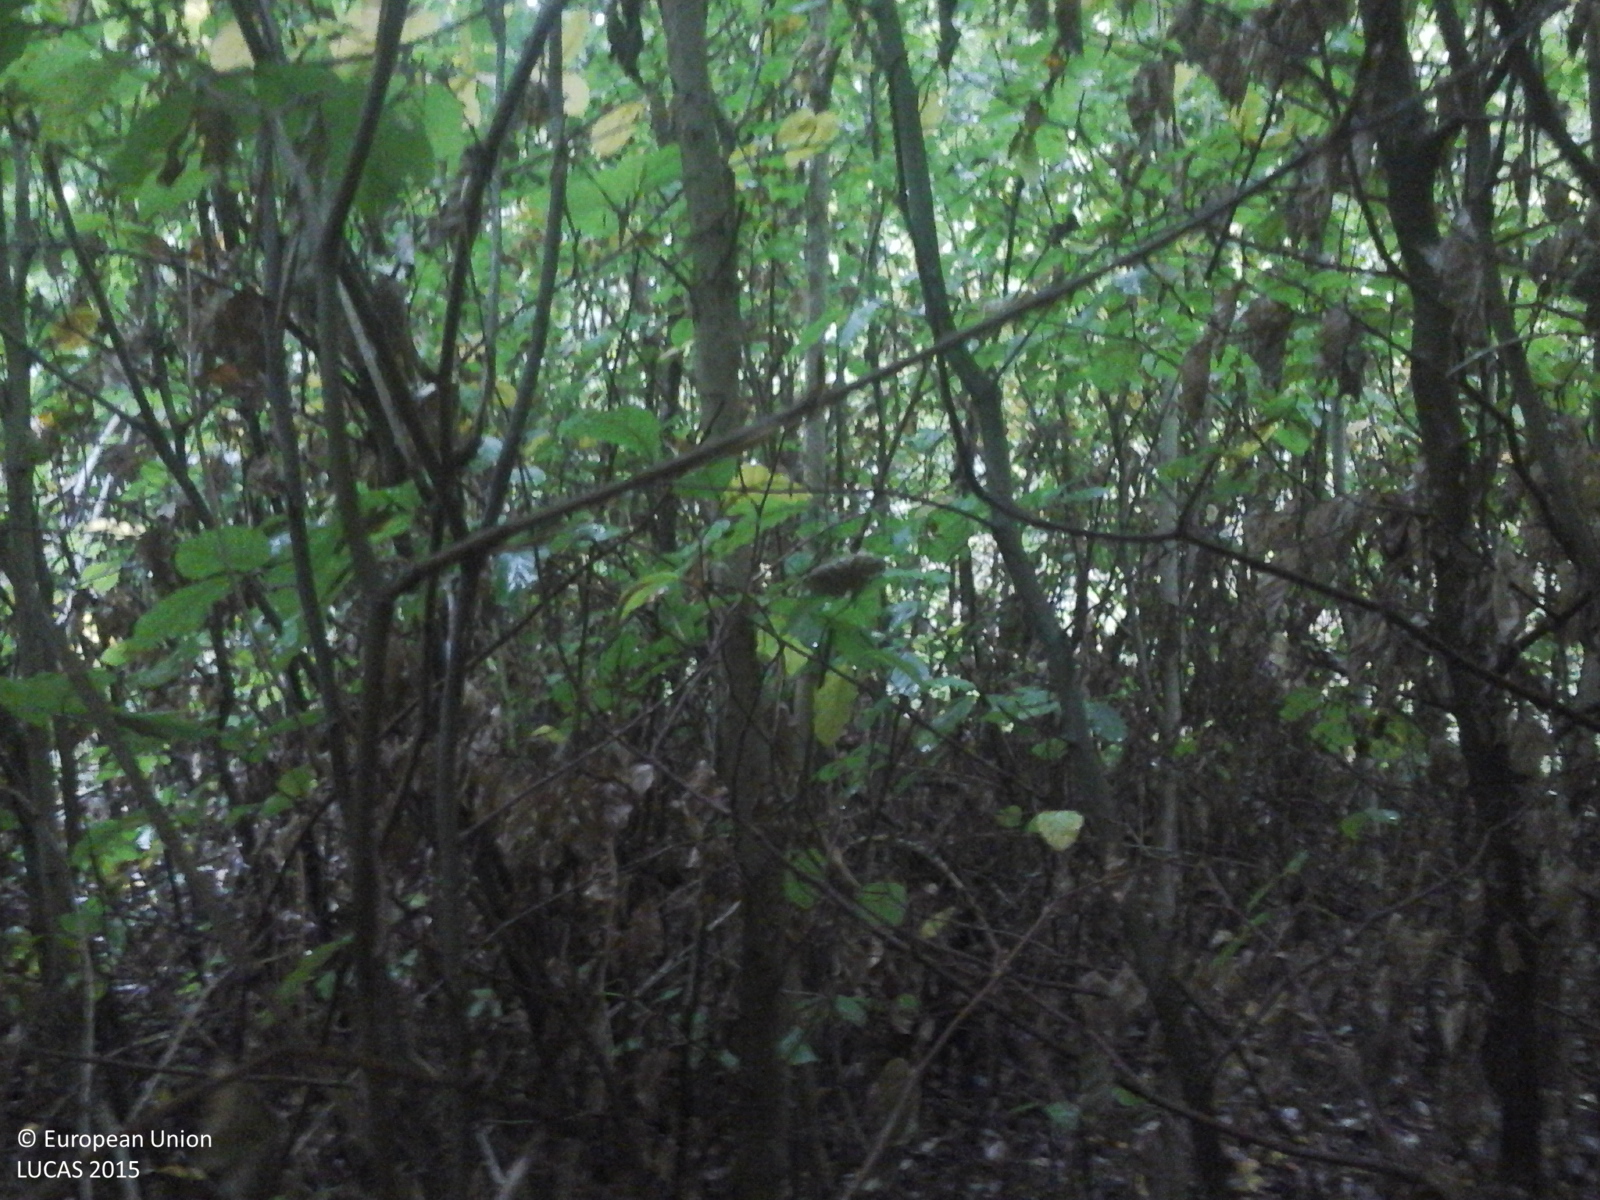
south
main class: Woodland
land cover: Broadleaved woodland
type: beech forest
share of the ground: > 75 %
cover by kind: broadleaved forest trees 100 %
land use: Forestry
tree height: < 5 m
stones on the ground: < 10 %
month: October
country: RO
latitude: 46.3689
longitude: 24.9799
